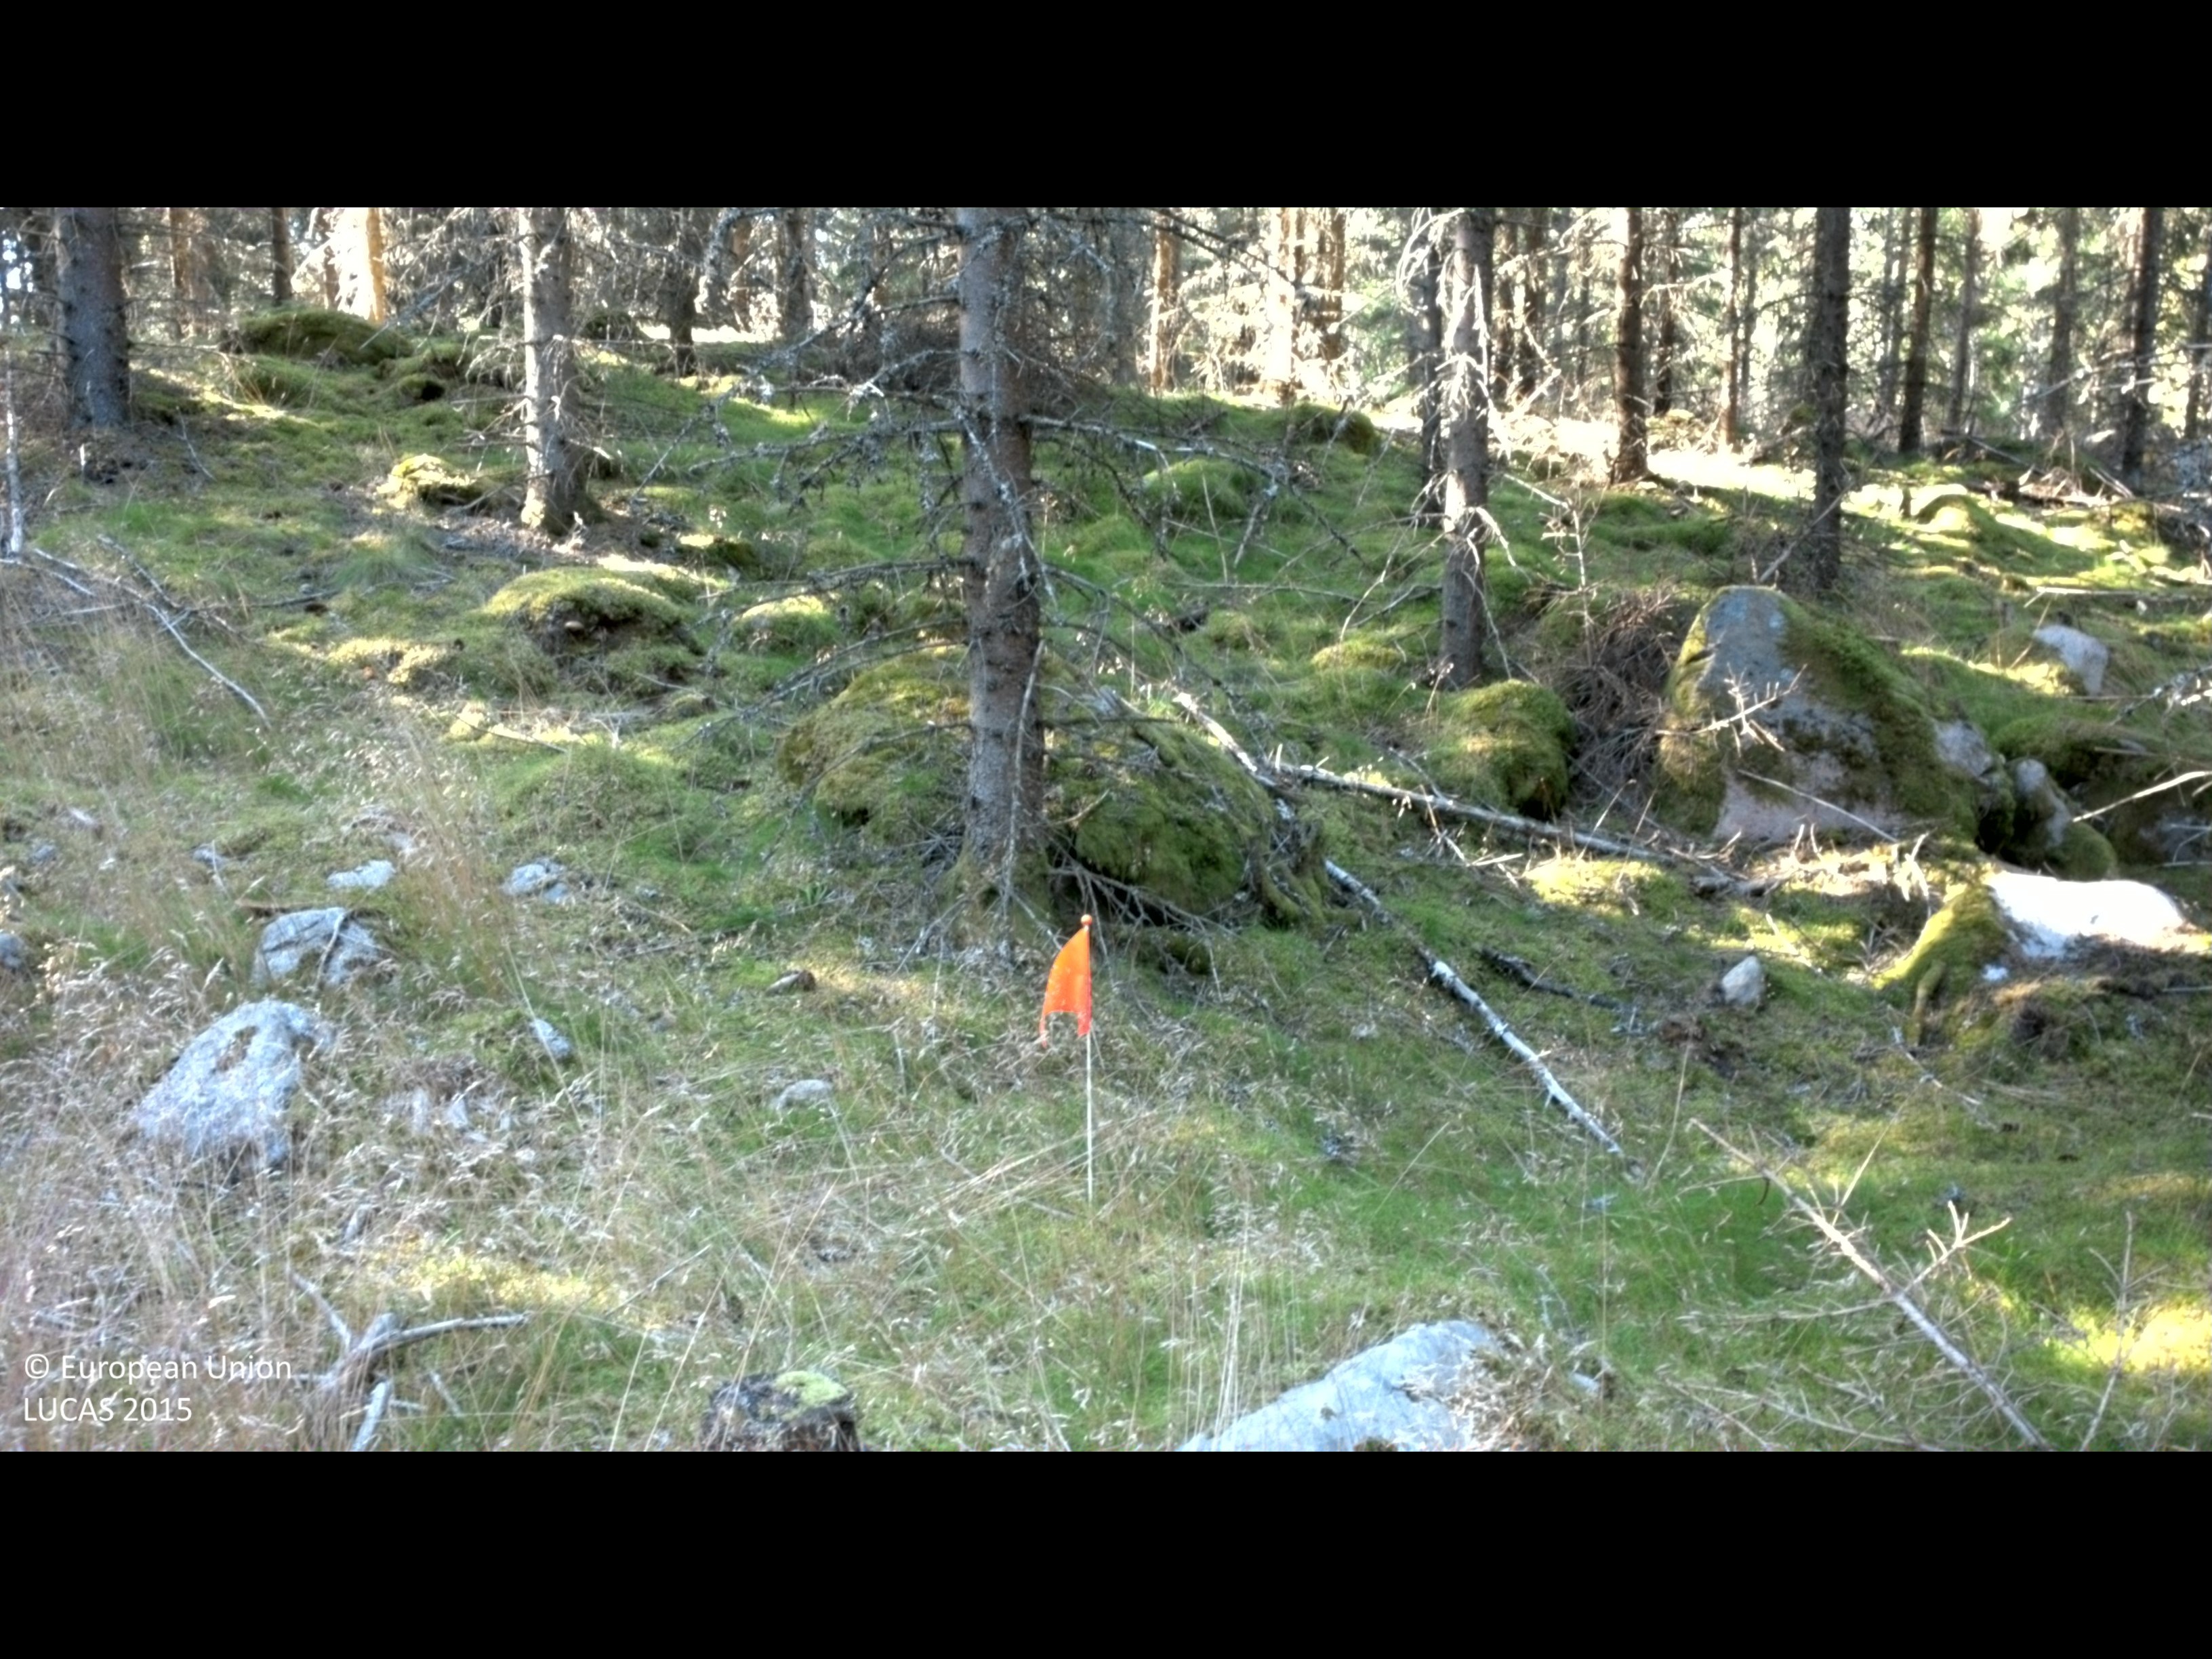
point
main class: Woodland
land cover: Spruce dominated coniferous woodland
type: boreal forest
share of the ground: > 75 %
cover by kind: coniferous forest trees 85 %, lichens and mosses 10 %, herbaceous plants 5 %
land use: Forestry
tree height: > 5 m
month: August
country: SE
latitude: 56.8200
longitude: 14.2401
